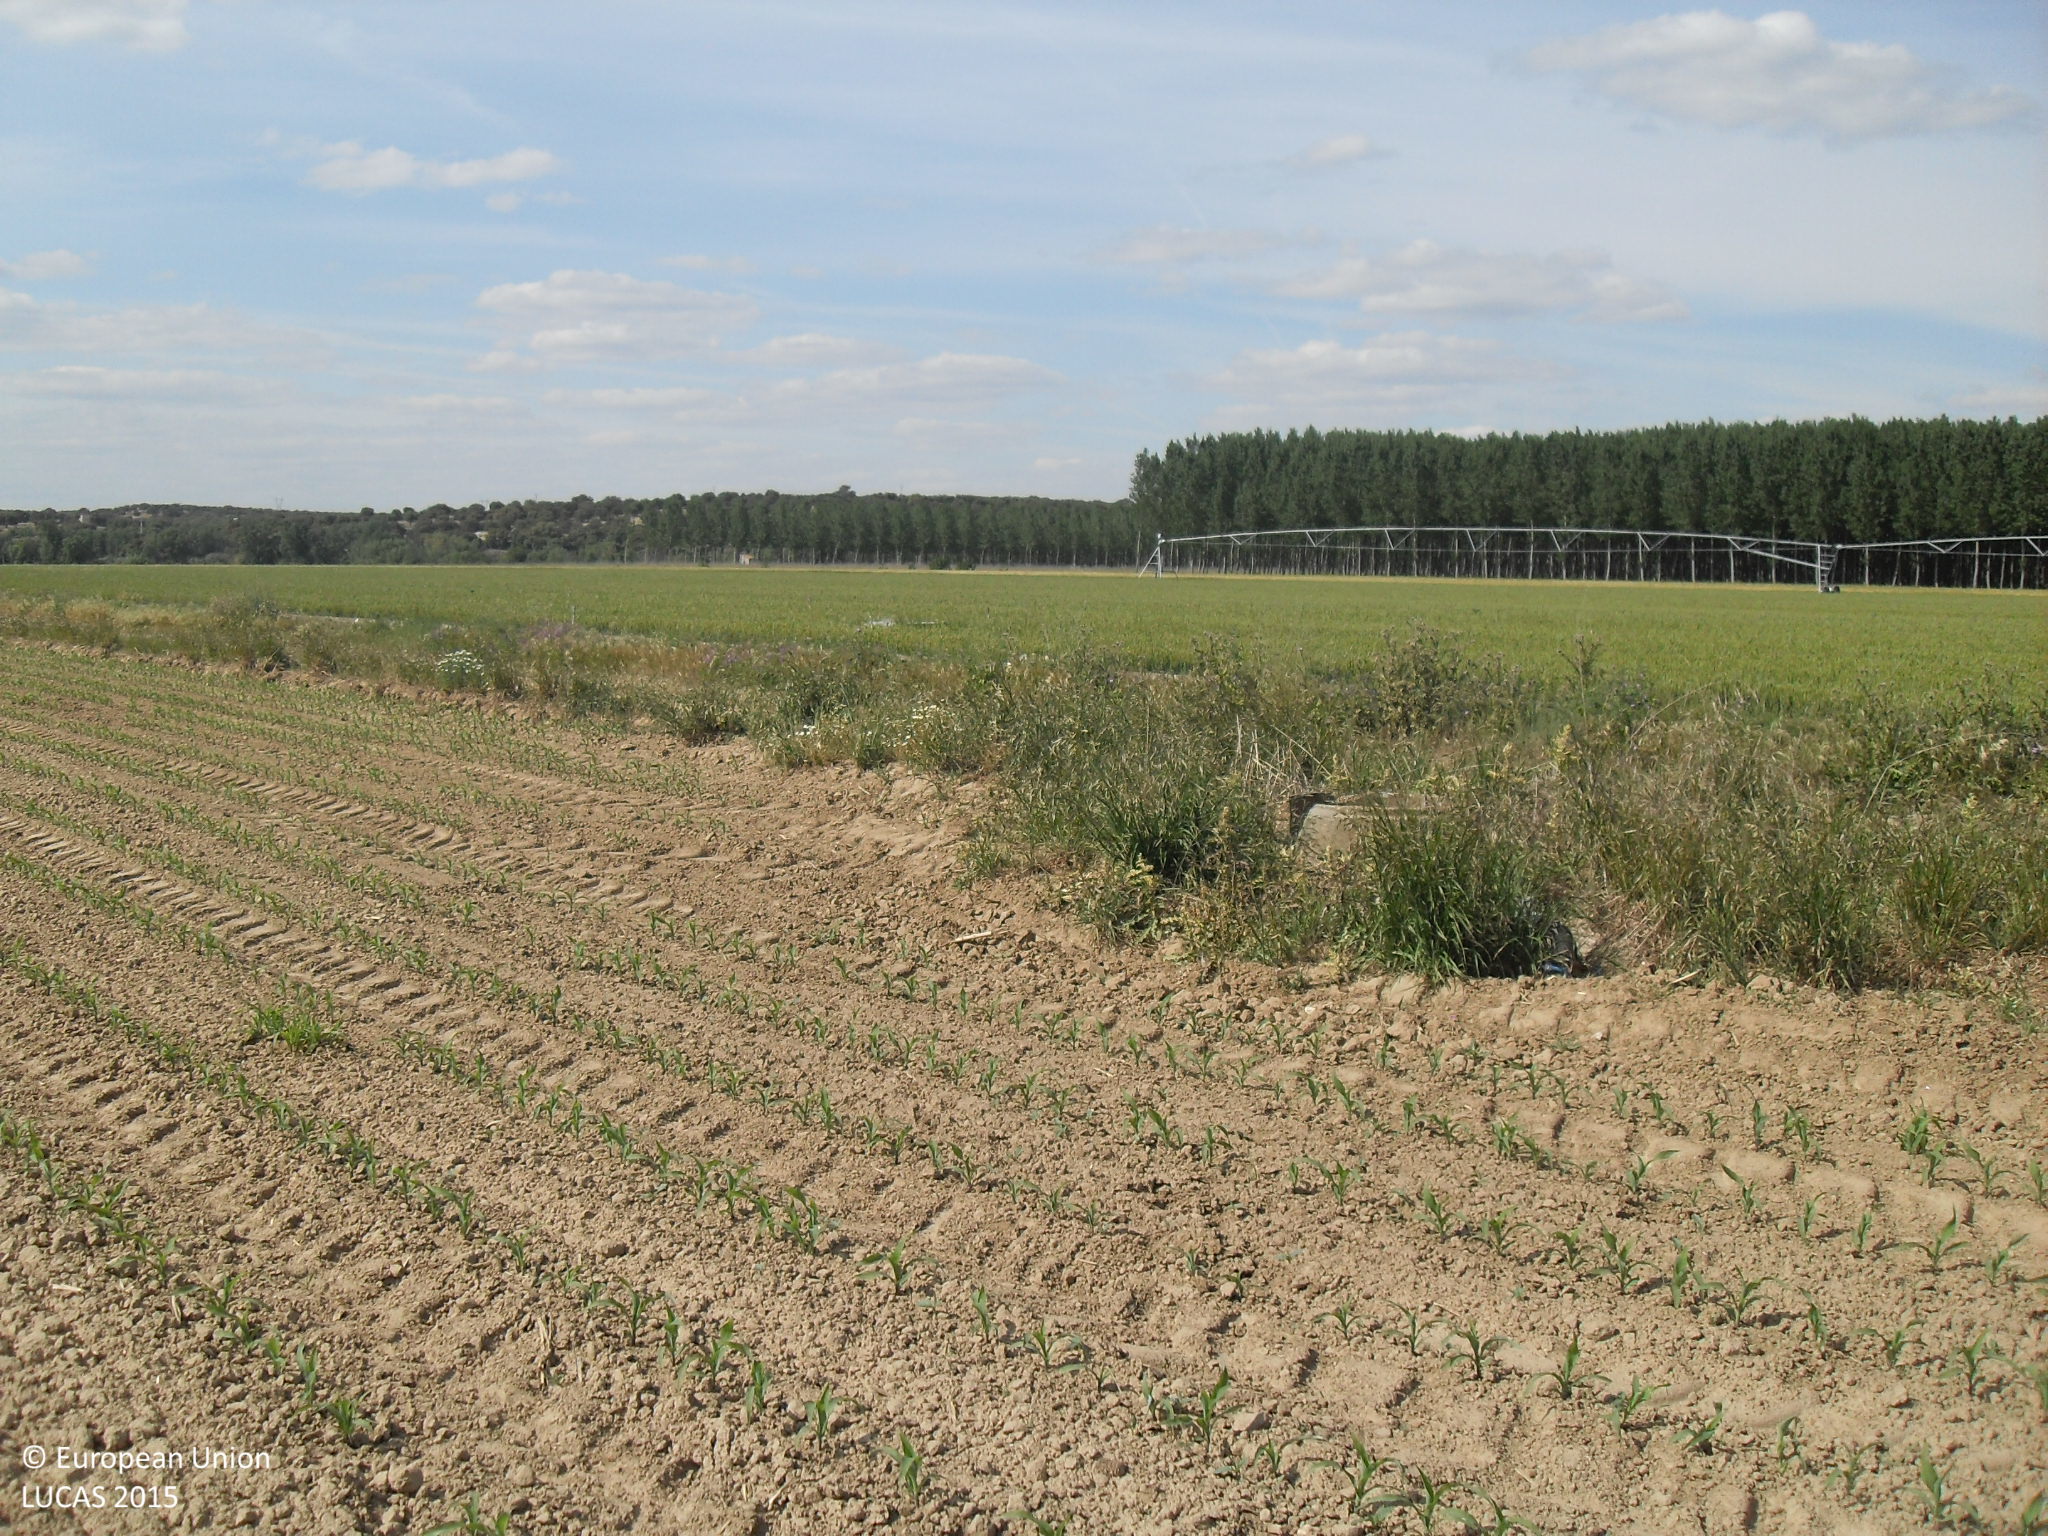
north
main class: Cropland
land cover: Maize
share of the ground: < 10 %
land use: Agriculture (excluding fallow land and kitchen gardens)
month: May
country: ES
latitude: 41.0280
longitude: -5.7435
